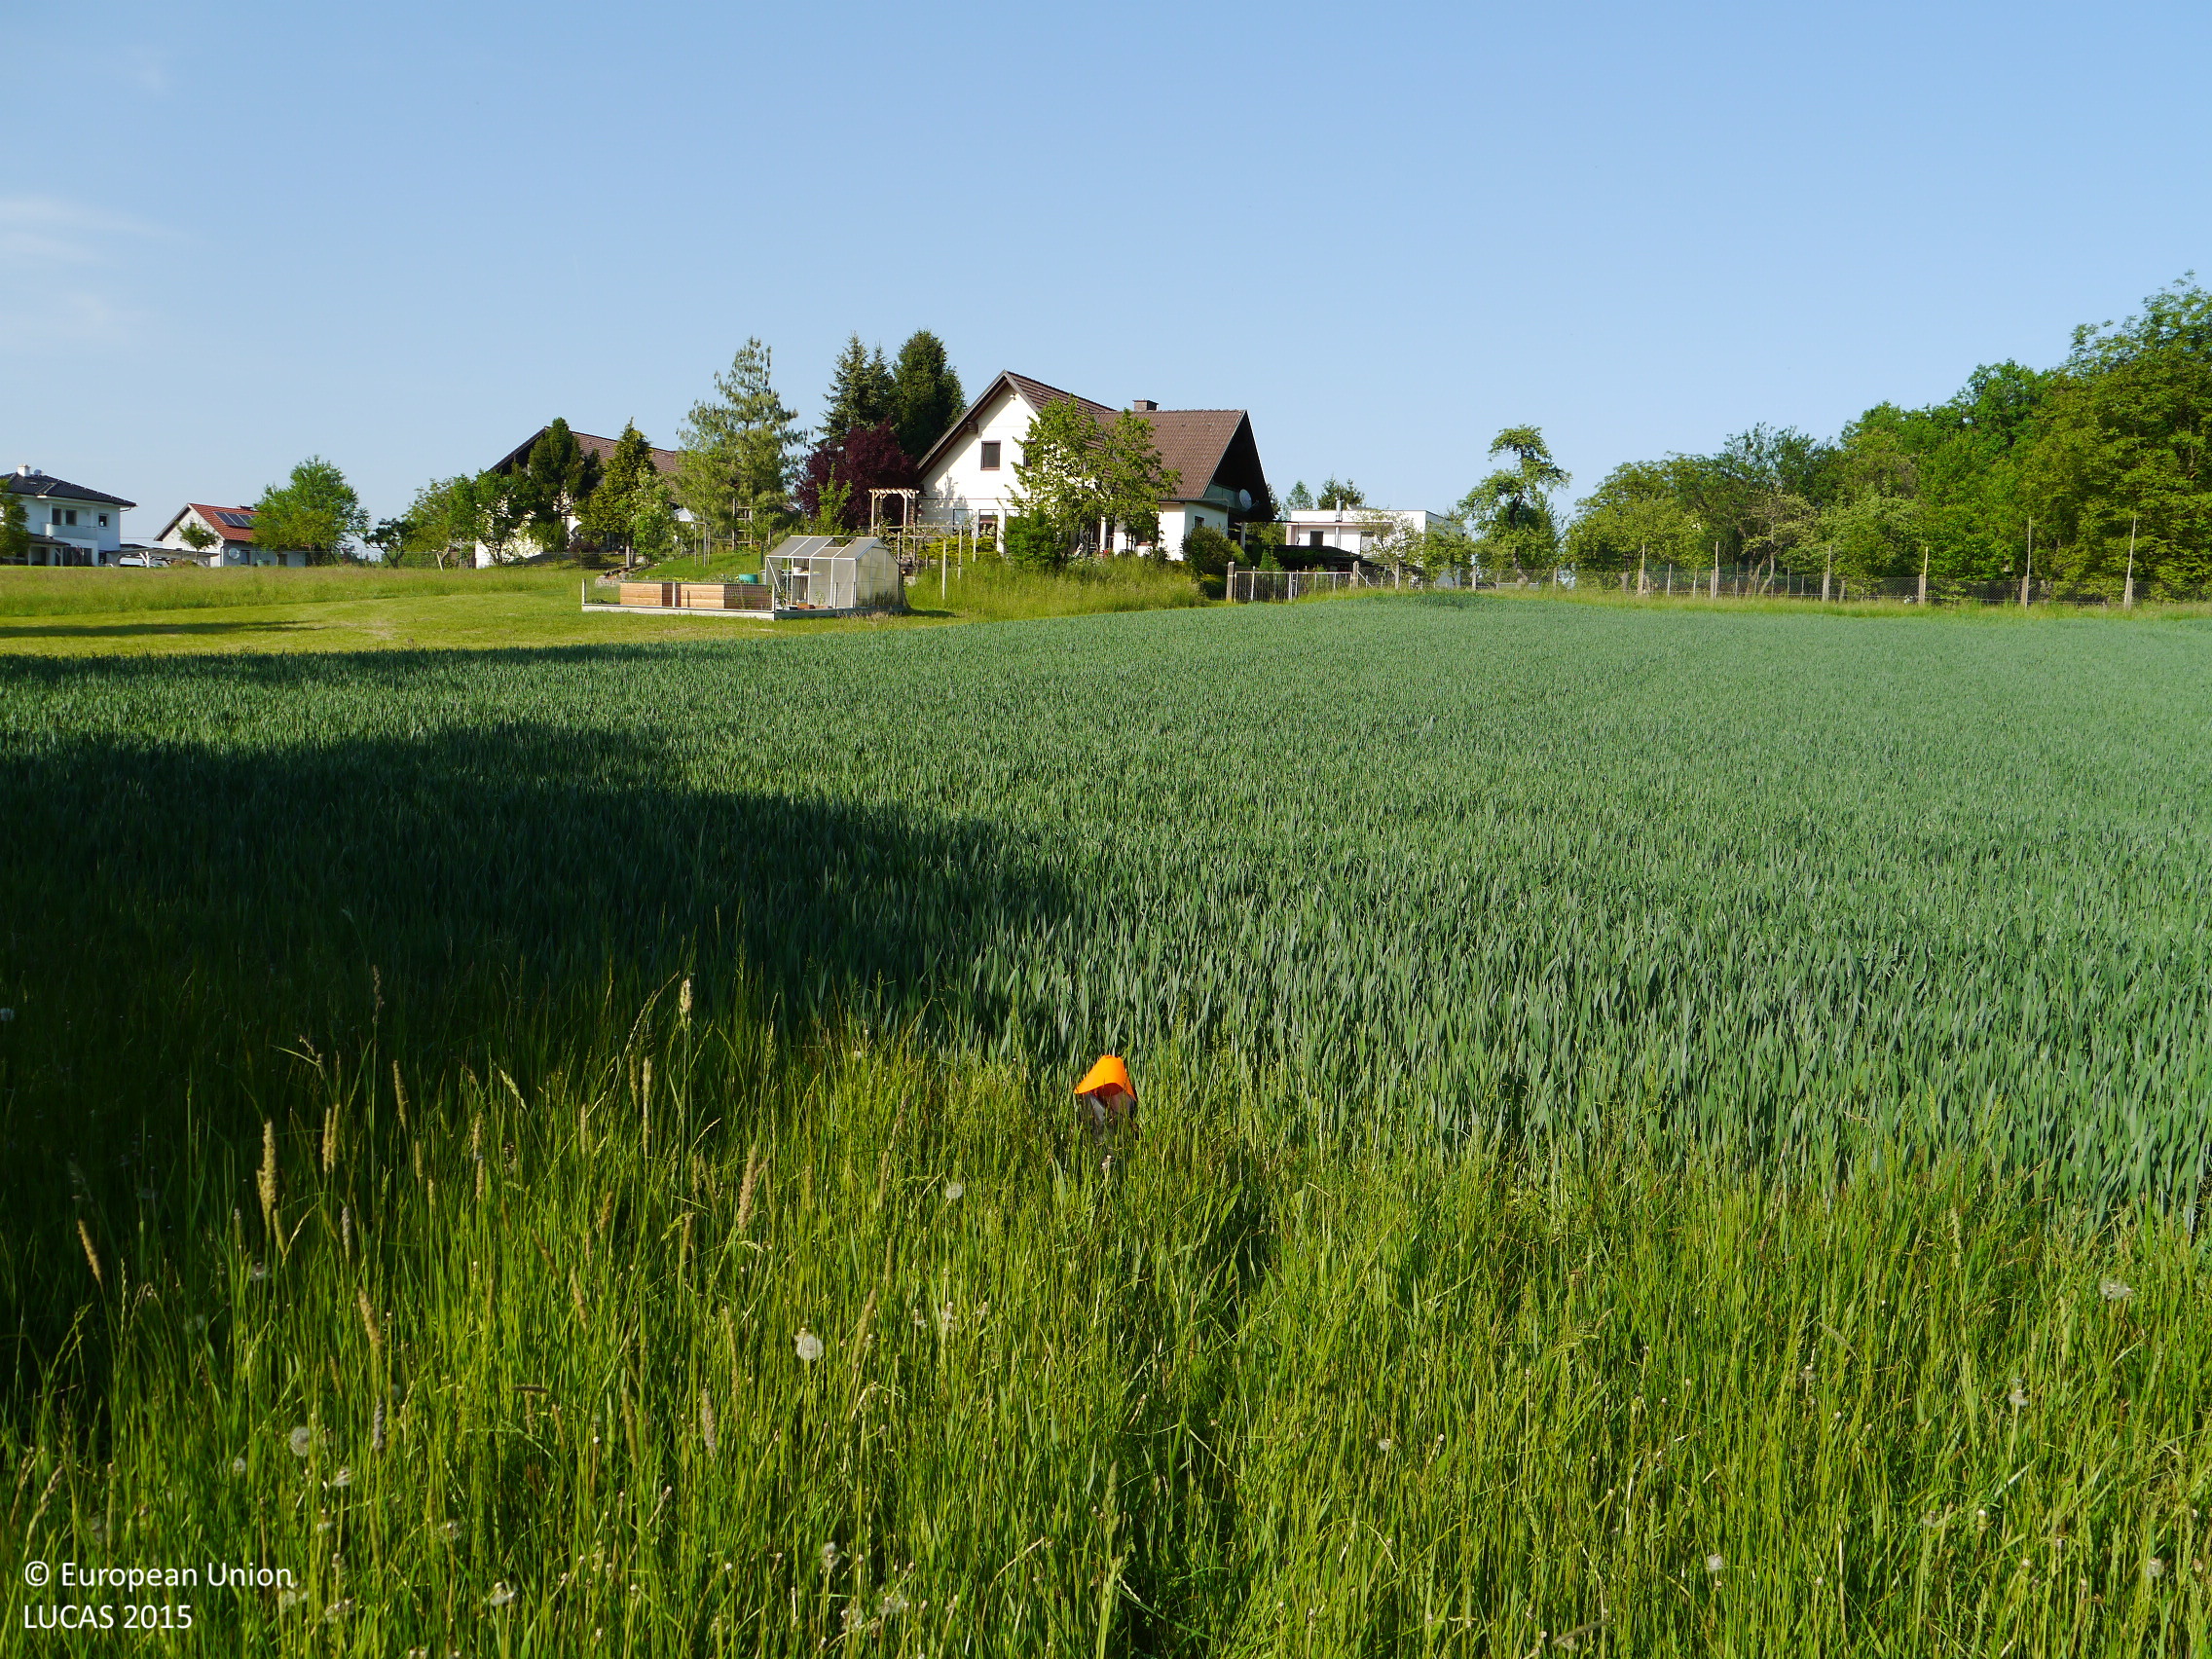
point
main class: Cropland
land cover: Common wheat
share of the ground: > 75 %
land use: Agriculture (excluding fallow land and kitchen gardens)
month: May
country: AT
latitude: 46.9548
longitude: 15.4001
